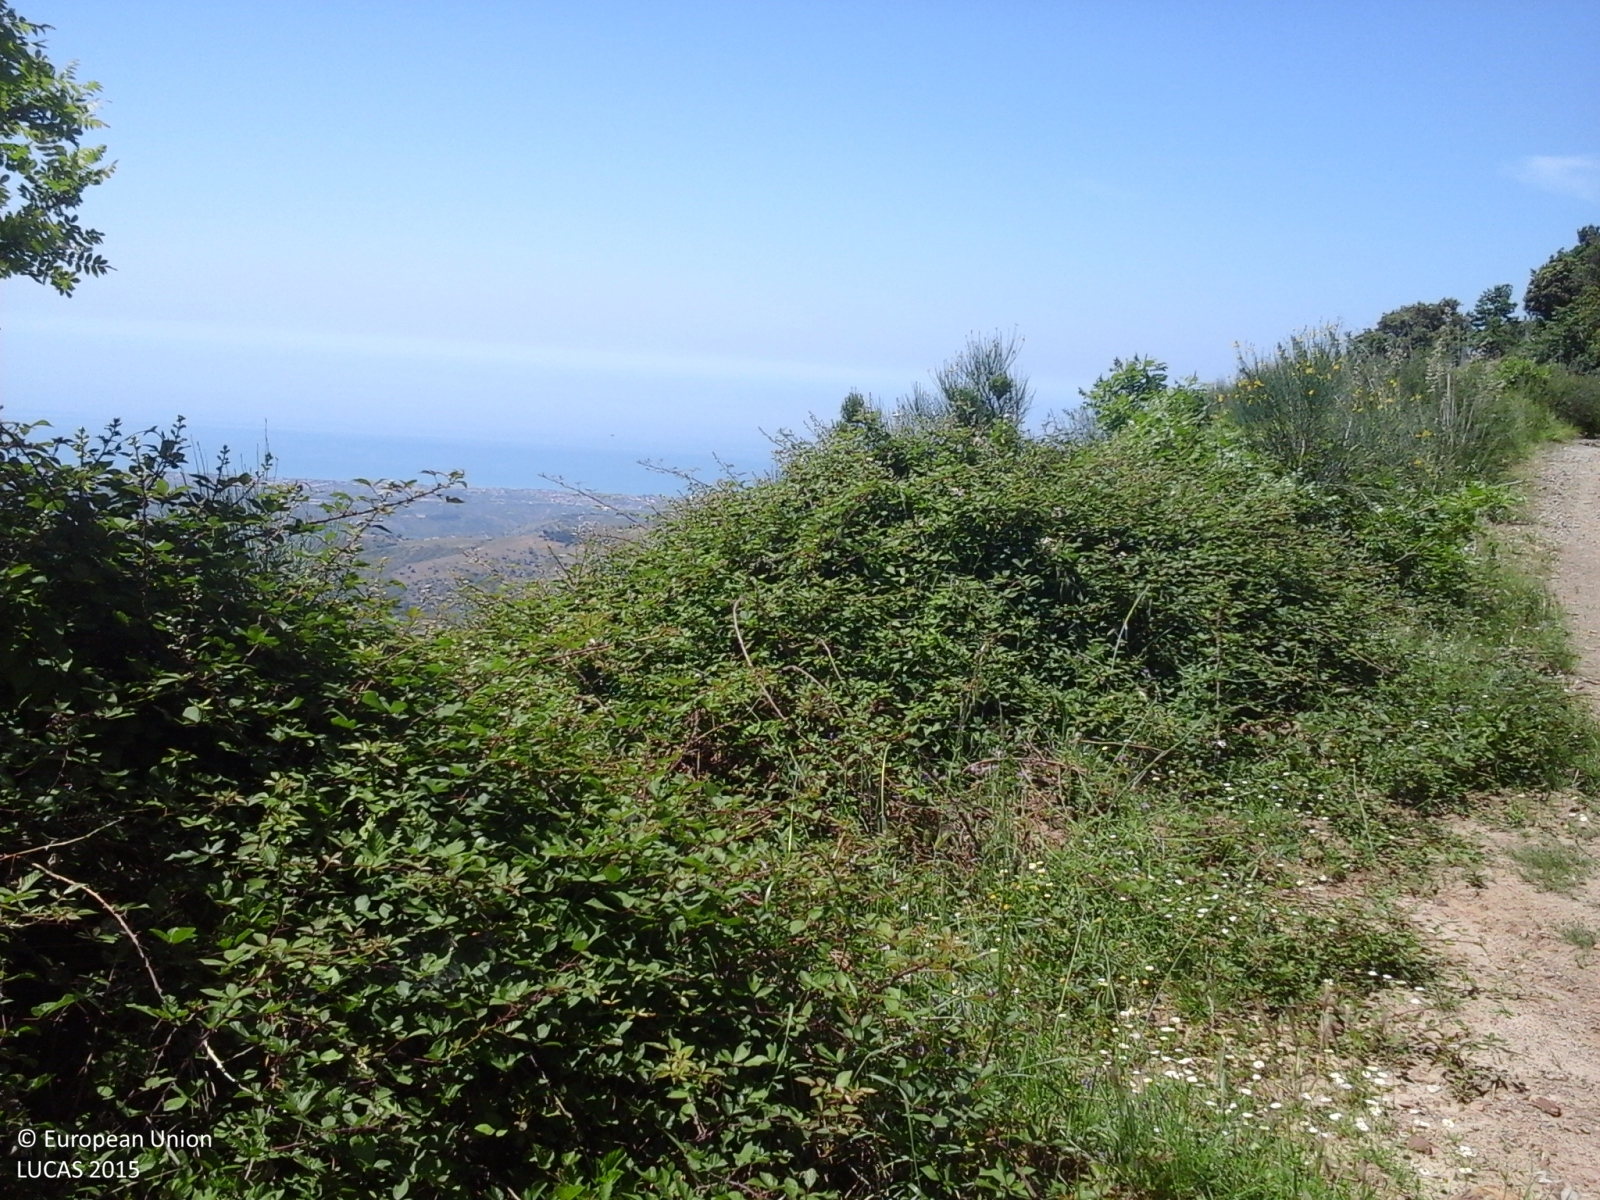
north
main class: Shrubland
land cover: Shrubland with sparse tree cover
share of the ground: > 75 %
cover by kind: shrubs 55 %, herbaceous plants 40 %, broadleaved forest trees 5 %
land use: Agriculture (excluding fallow land and kitchen gardens)
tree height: < 5 m
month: June
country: IT
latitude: 37.9555
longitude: 13.9669
